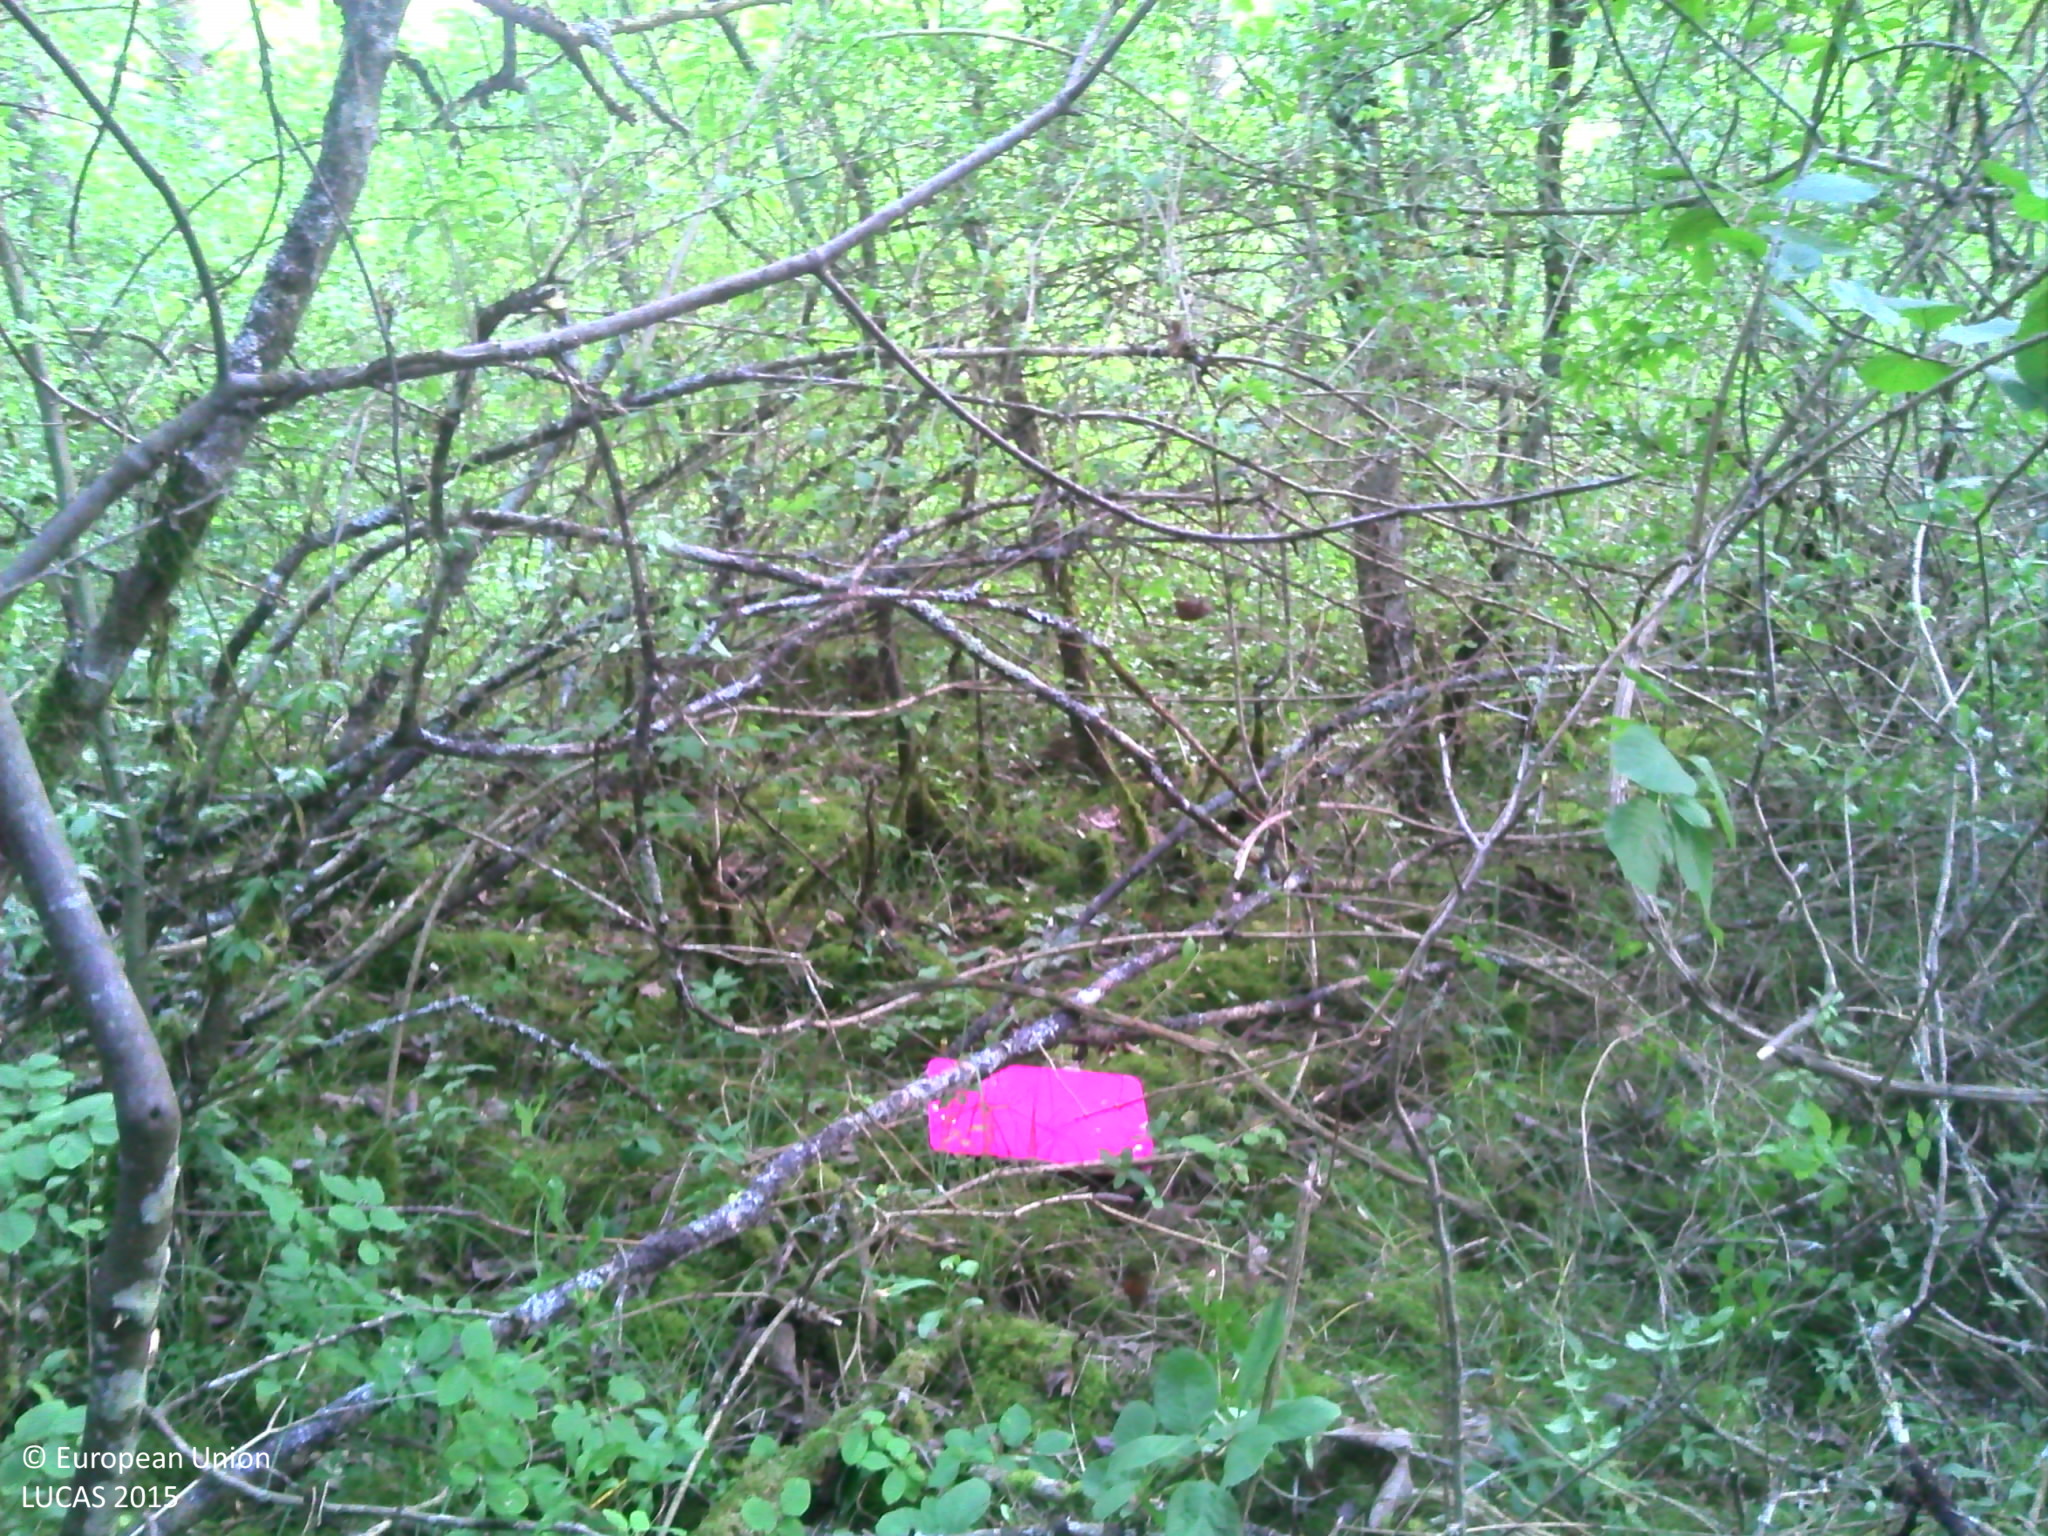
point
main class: Woodland
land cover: Pine dominated coniferous woodland
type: mesophytic deciduous forest
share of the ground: > 75 %
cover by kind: coniferous forest trees 80 %, broadleaved forest trees 10 %, herbaceous plants 5 %, lichens and mosses 5 %
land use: Semi-natural and natural areas not in use
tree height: > 5 m
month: July
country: FR
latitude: 47.6743
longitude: 3.5628
